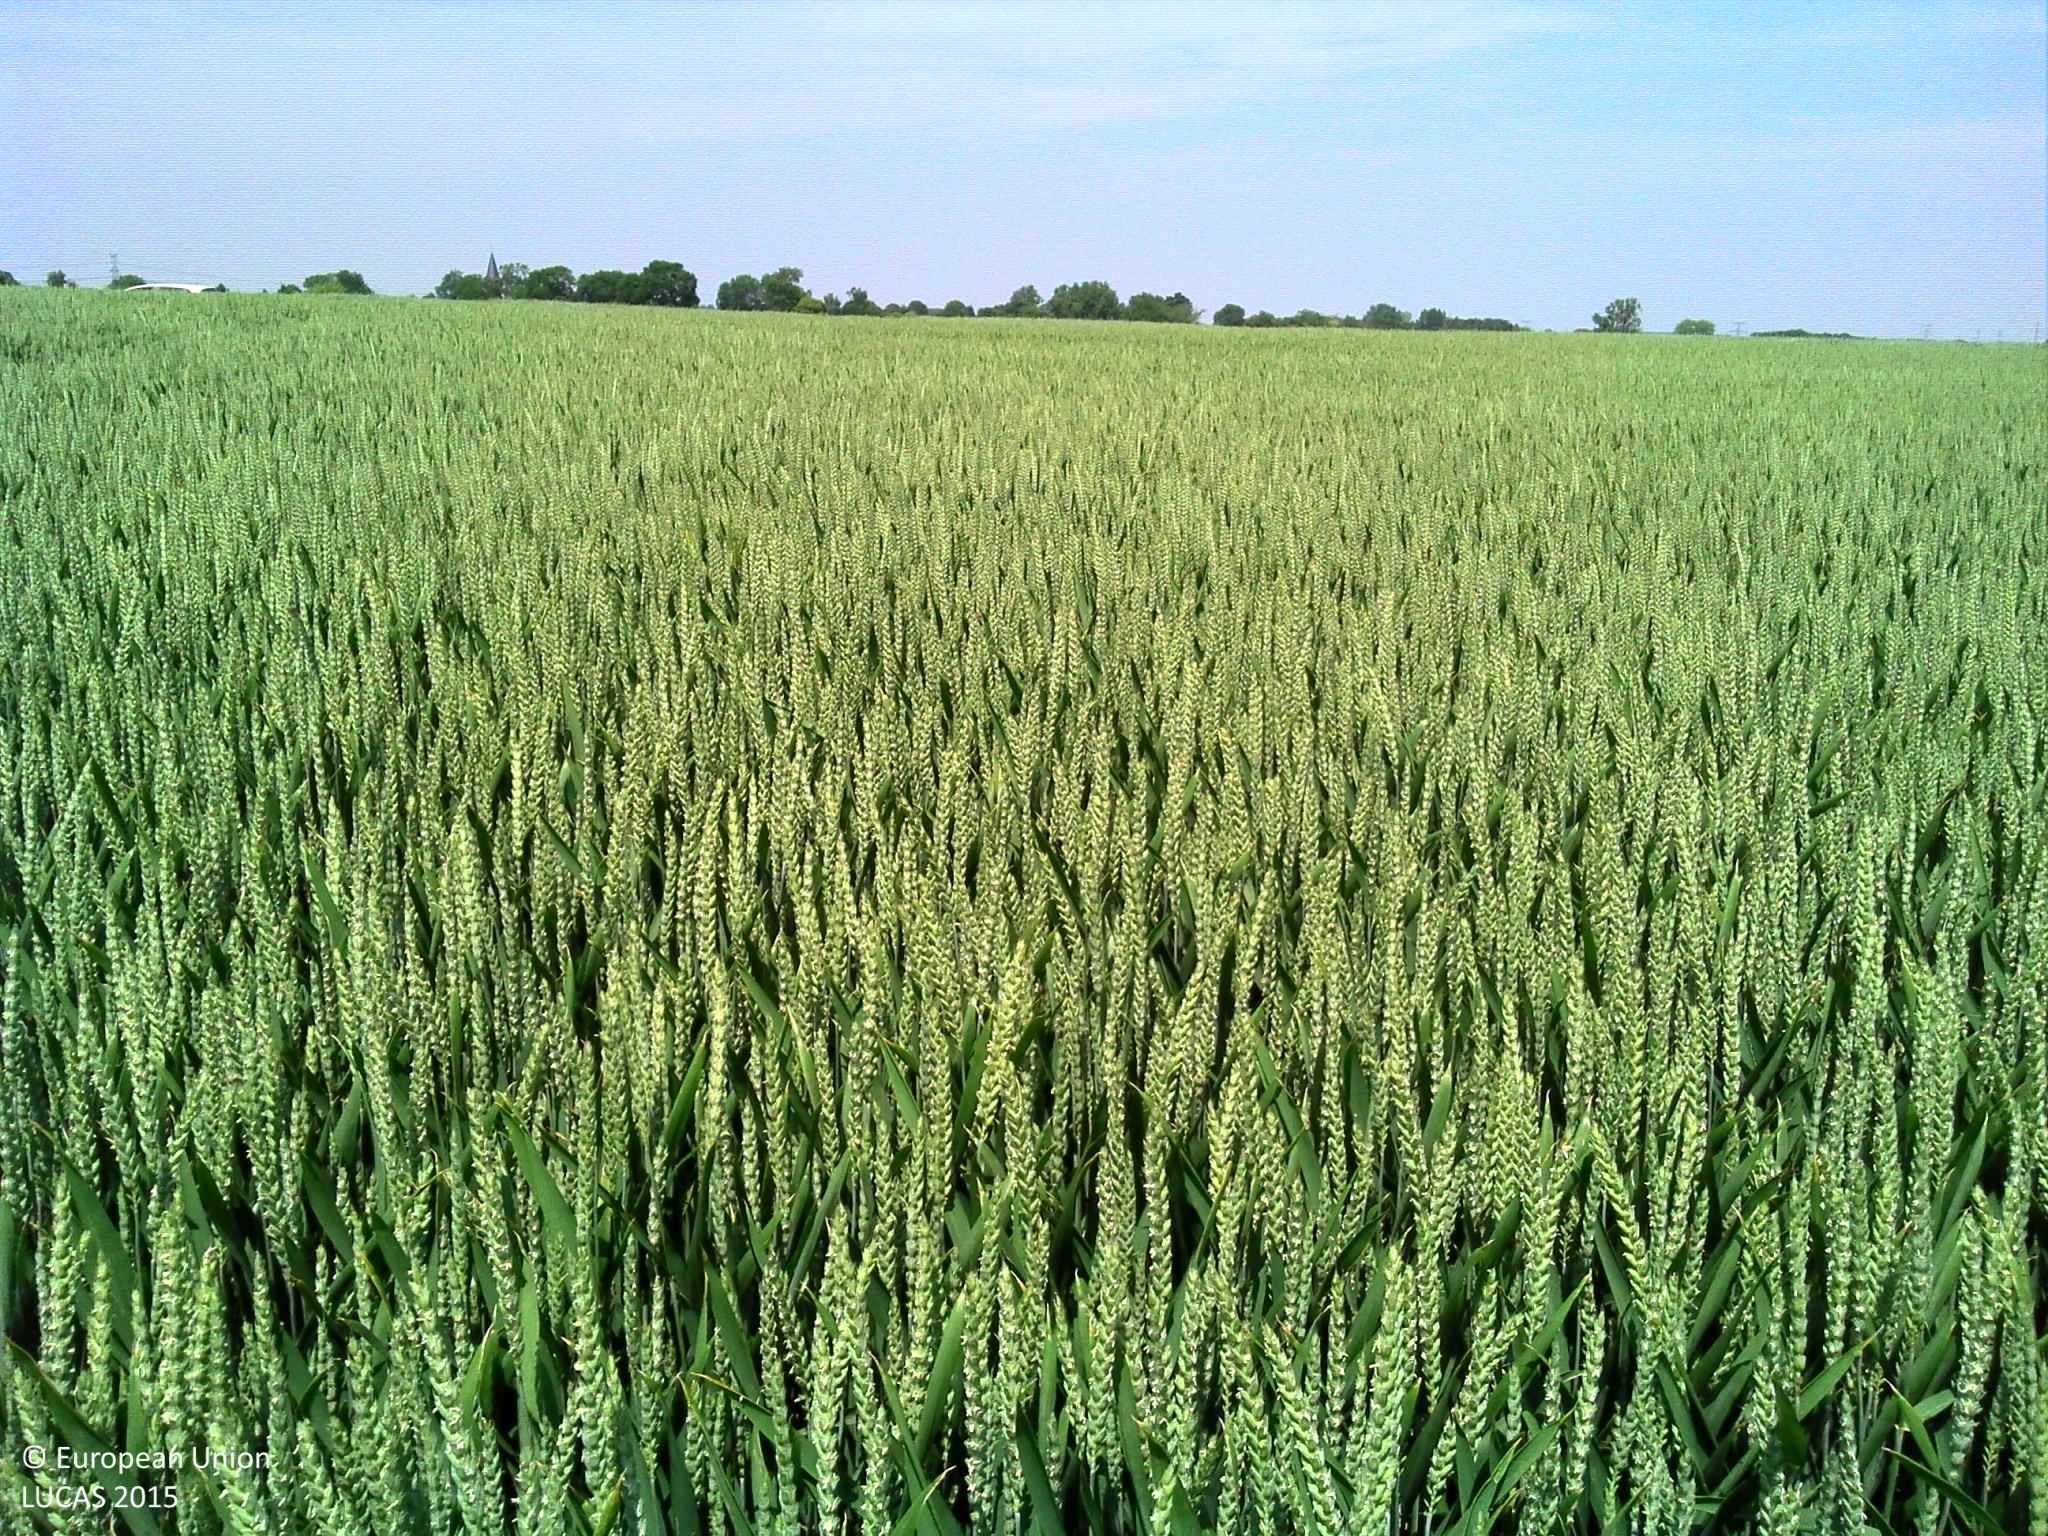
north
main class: Cropland
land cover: Common wheat
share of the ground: > 75 %
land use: Agriculture (excluding fallow land and kitchen gardens)
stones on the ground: < 10 %
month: June
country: FR
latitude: 50.2272
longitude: 2.7981
